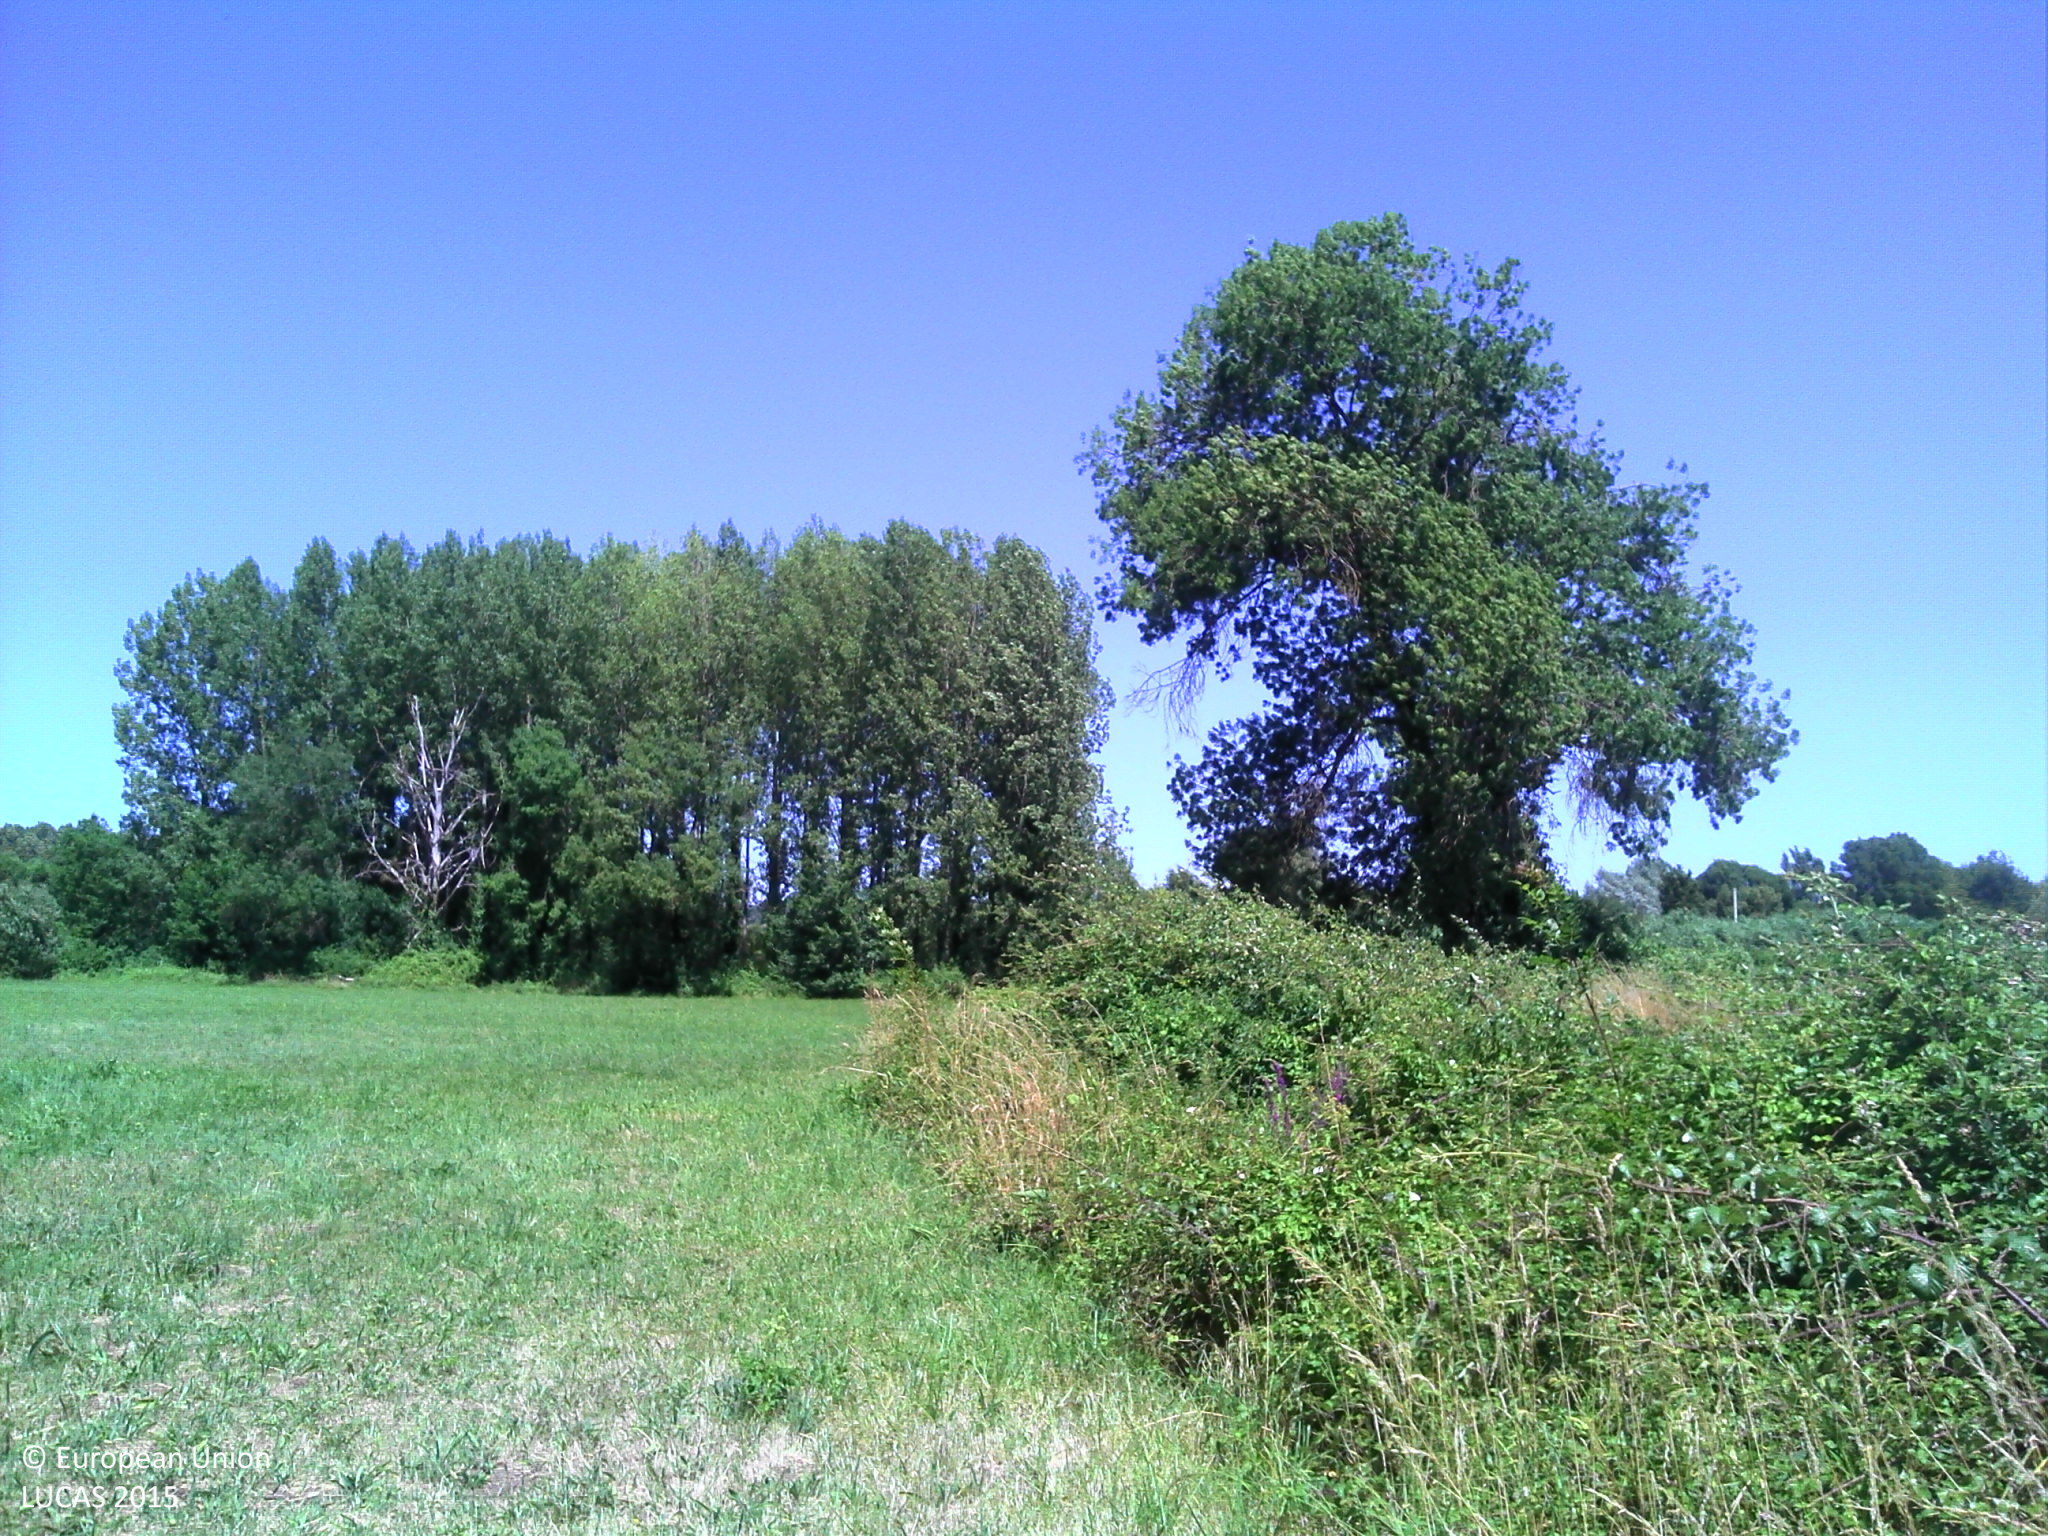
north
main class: Grassland
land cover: Grassland without tree/shrub cover
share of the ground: > 75 %
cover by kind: herbaceous plants 95 %, shrubs 5 %
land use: Agriculture (excluding fallow land and kitchen gardens)
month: July
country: FR
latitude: 47.6829
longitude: 0.2644
